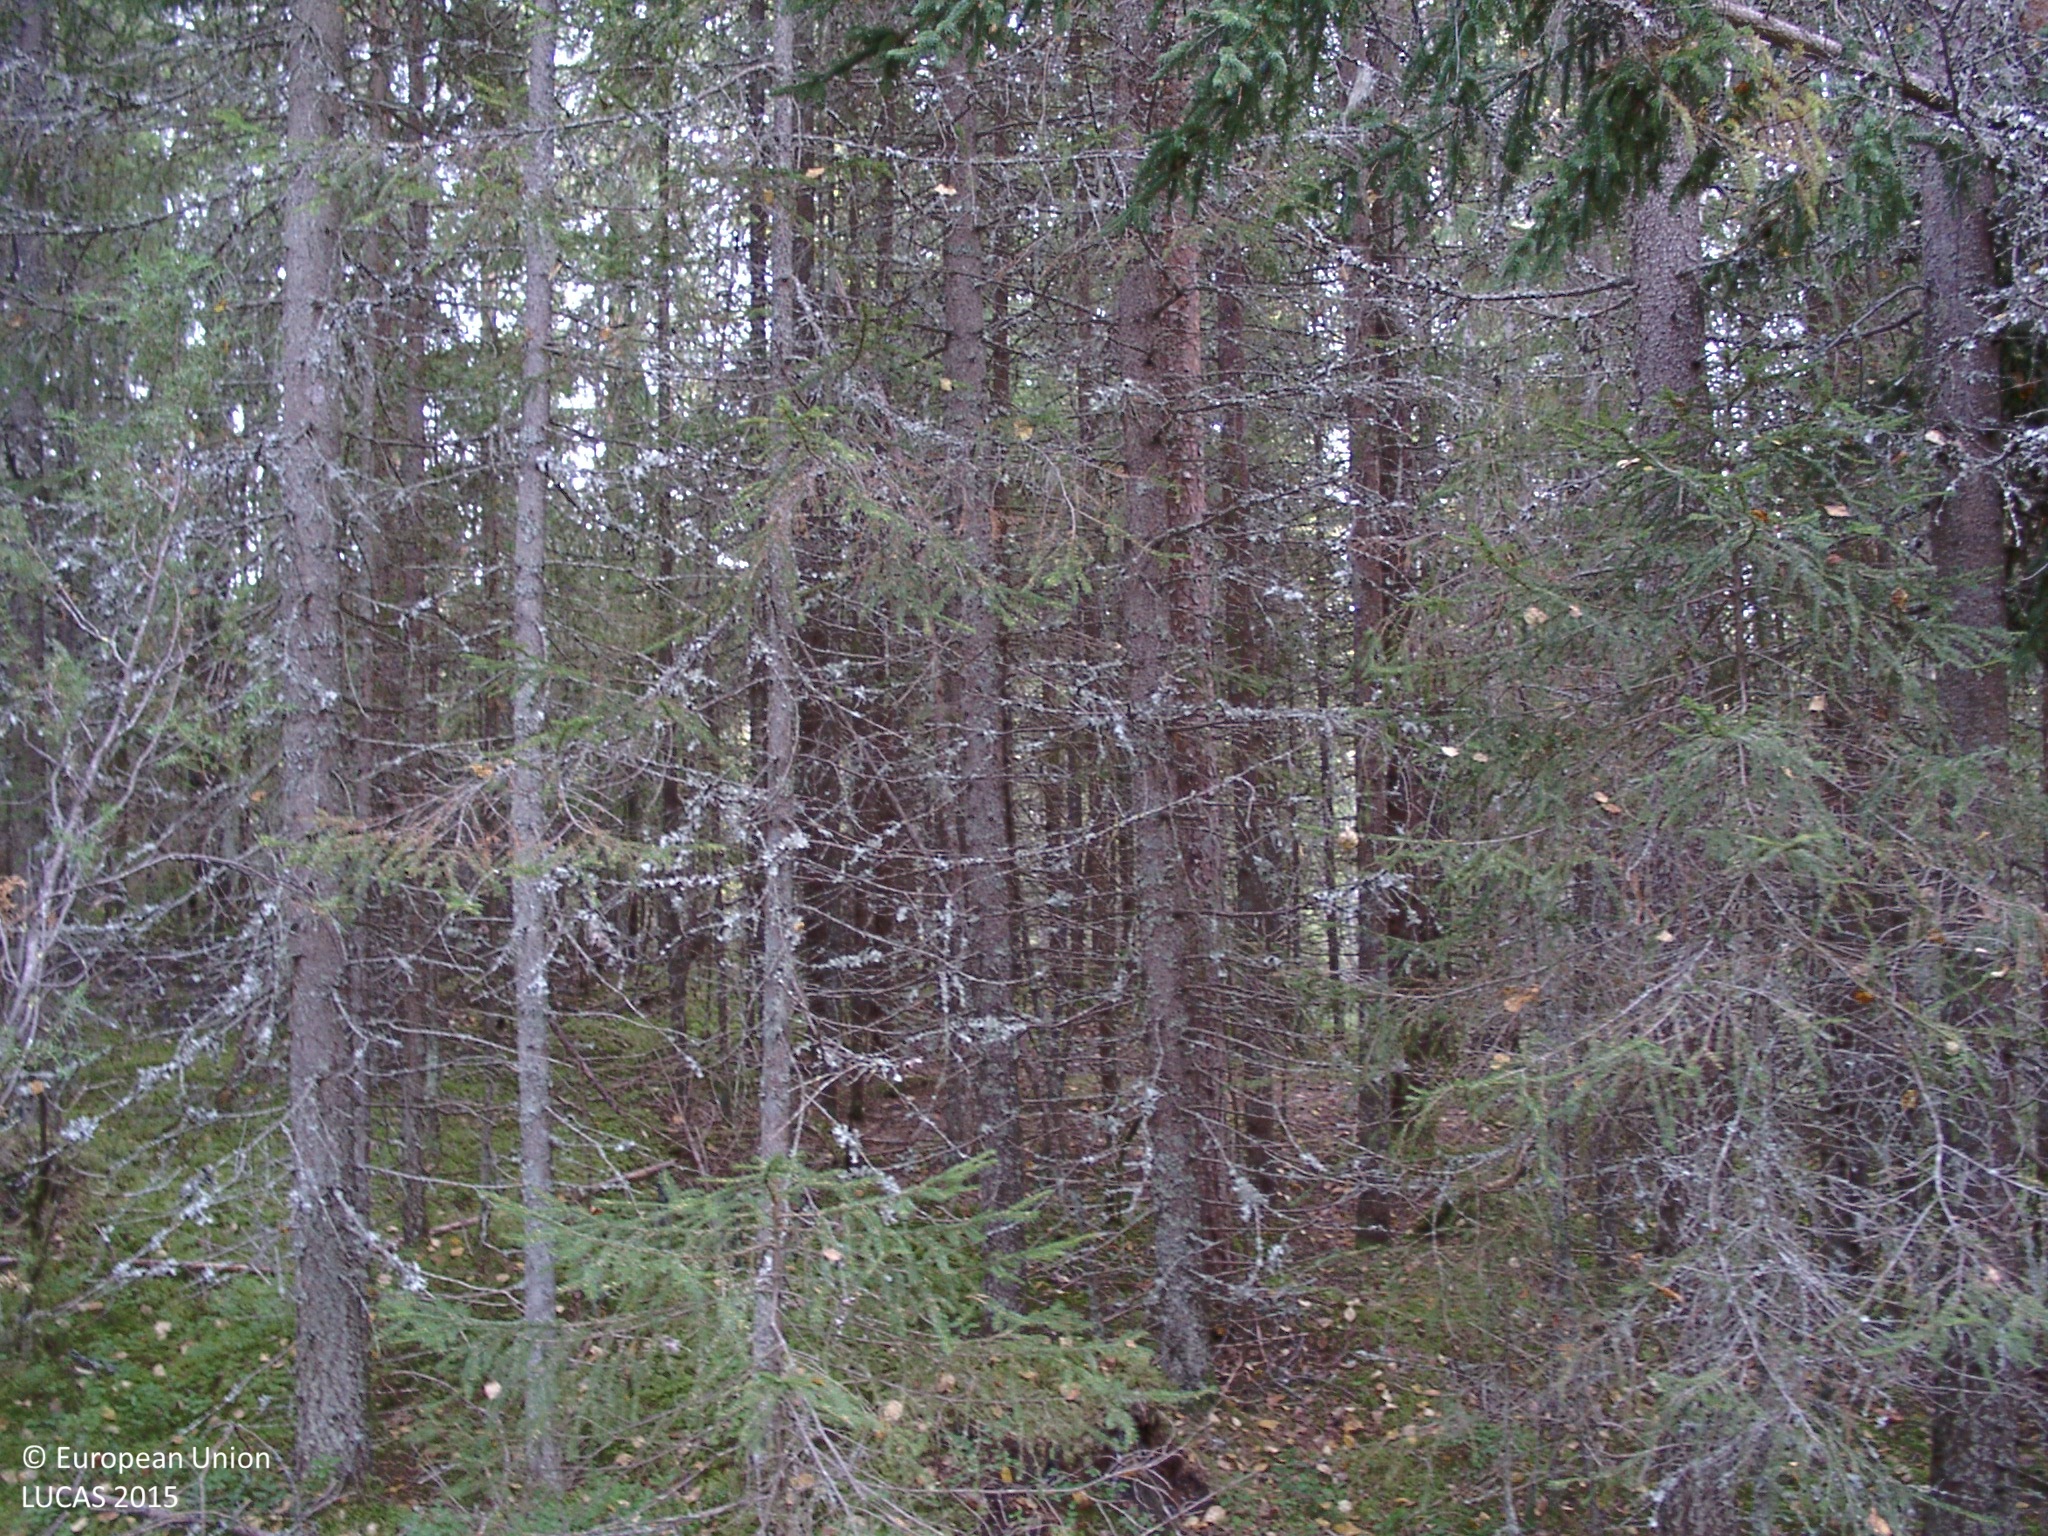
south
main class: Woodland
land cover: Spruce dominated coniferous woodland
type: boreal forest
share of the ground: > 75 %
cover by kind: coniferous forest trees 65 %, broadleaved forest trees 15 %, lichens and mosses 15 %, shrubs 5 %
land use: Forestry
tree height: > 5 m
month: September
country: FI
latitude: 62.8336
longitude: 25.1583
